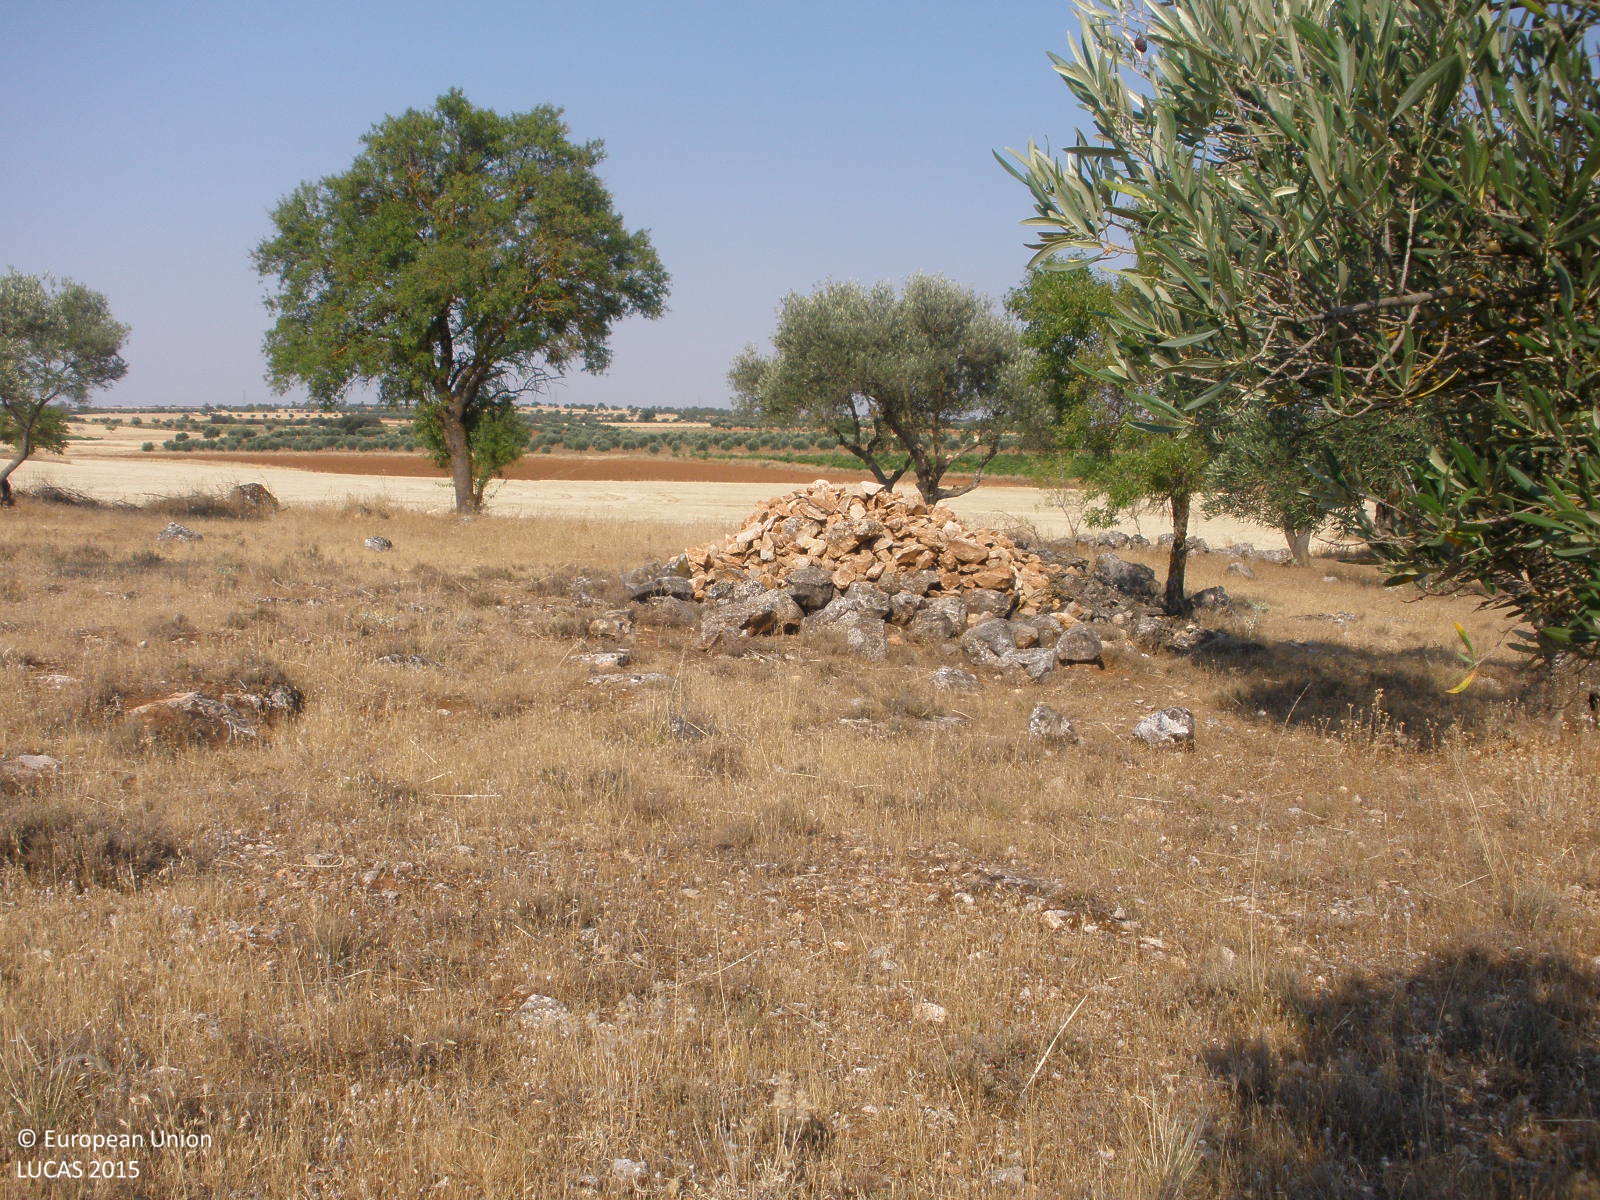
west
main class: Cropland
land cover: Olive groves
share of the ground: 25 - 50 %
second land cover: Shrubland without tree cover
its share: 10 - 25 %
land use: Agriculture (excluding fallow land and kitchen gardens)
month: June
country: ES
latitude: 40.2863
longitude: -3.3346
